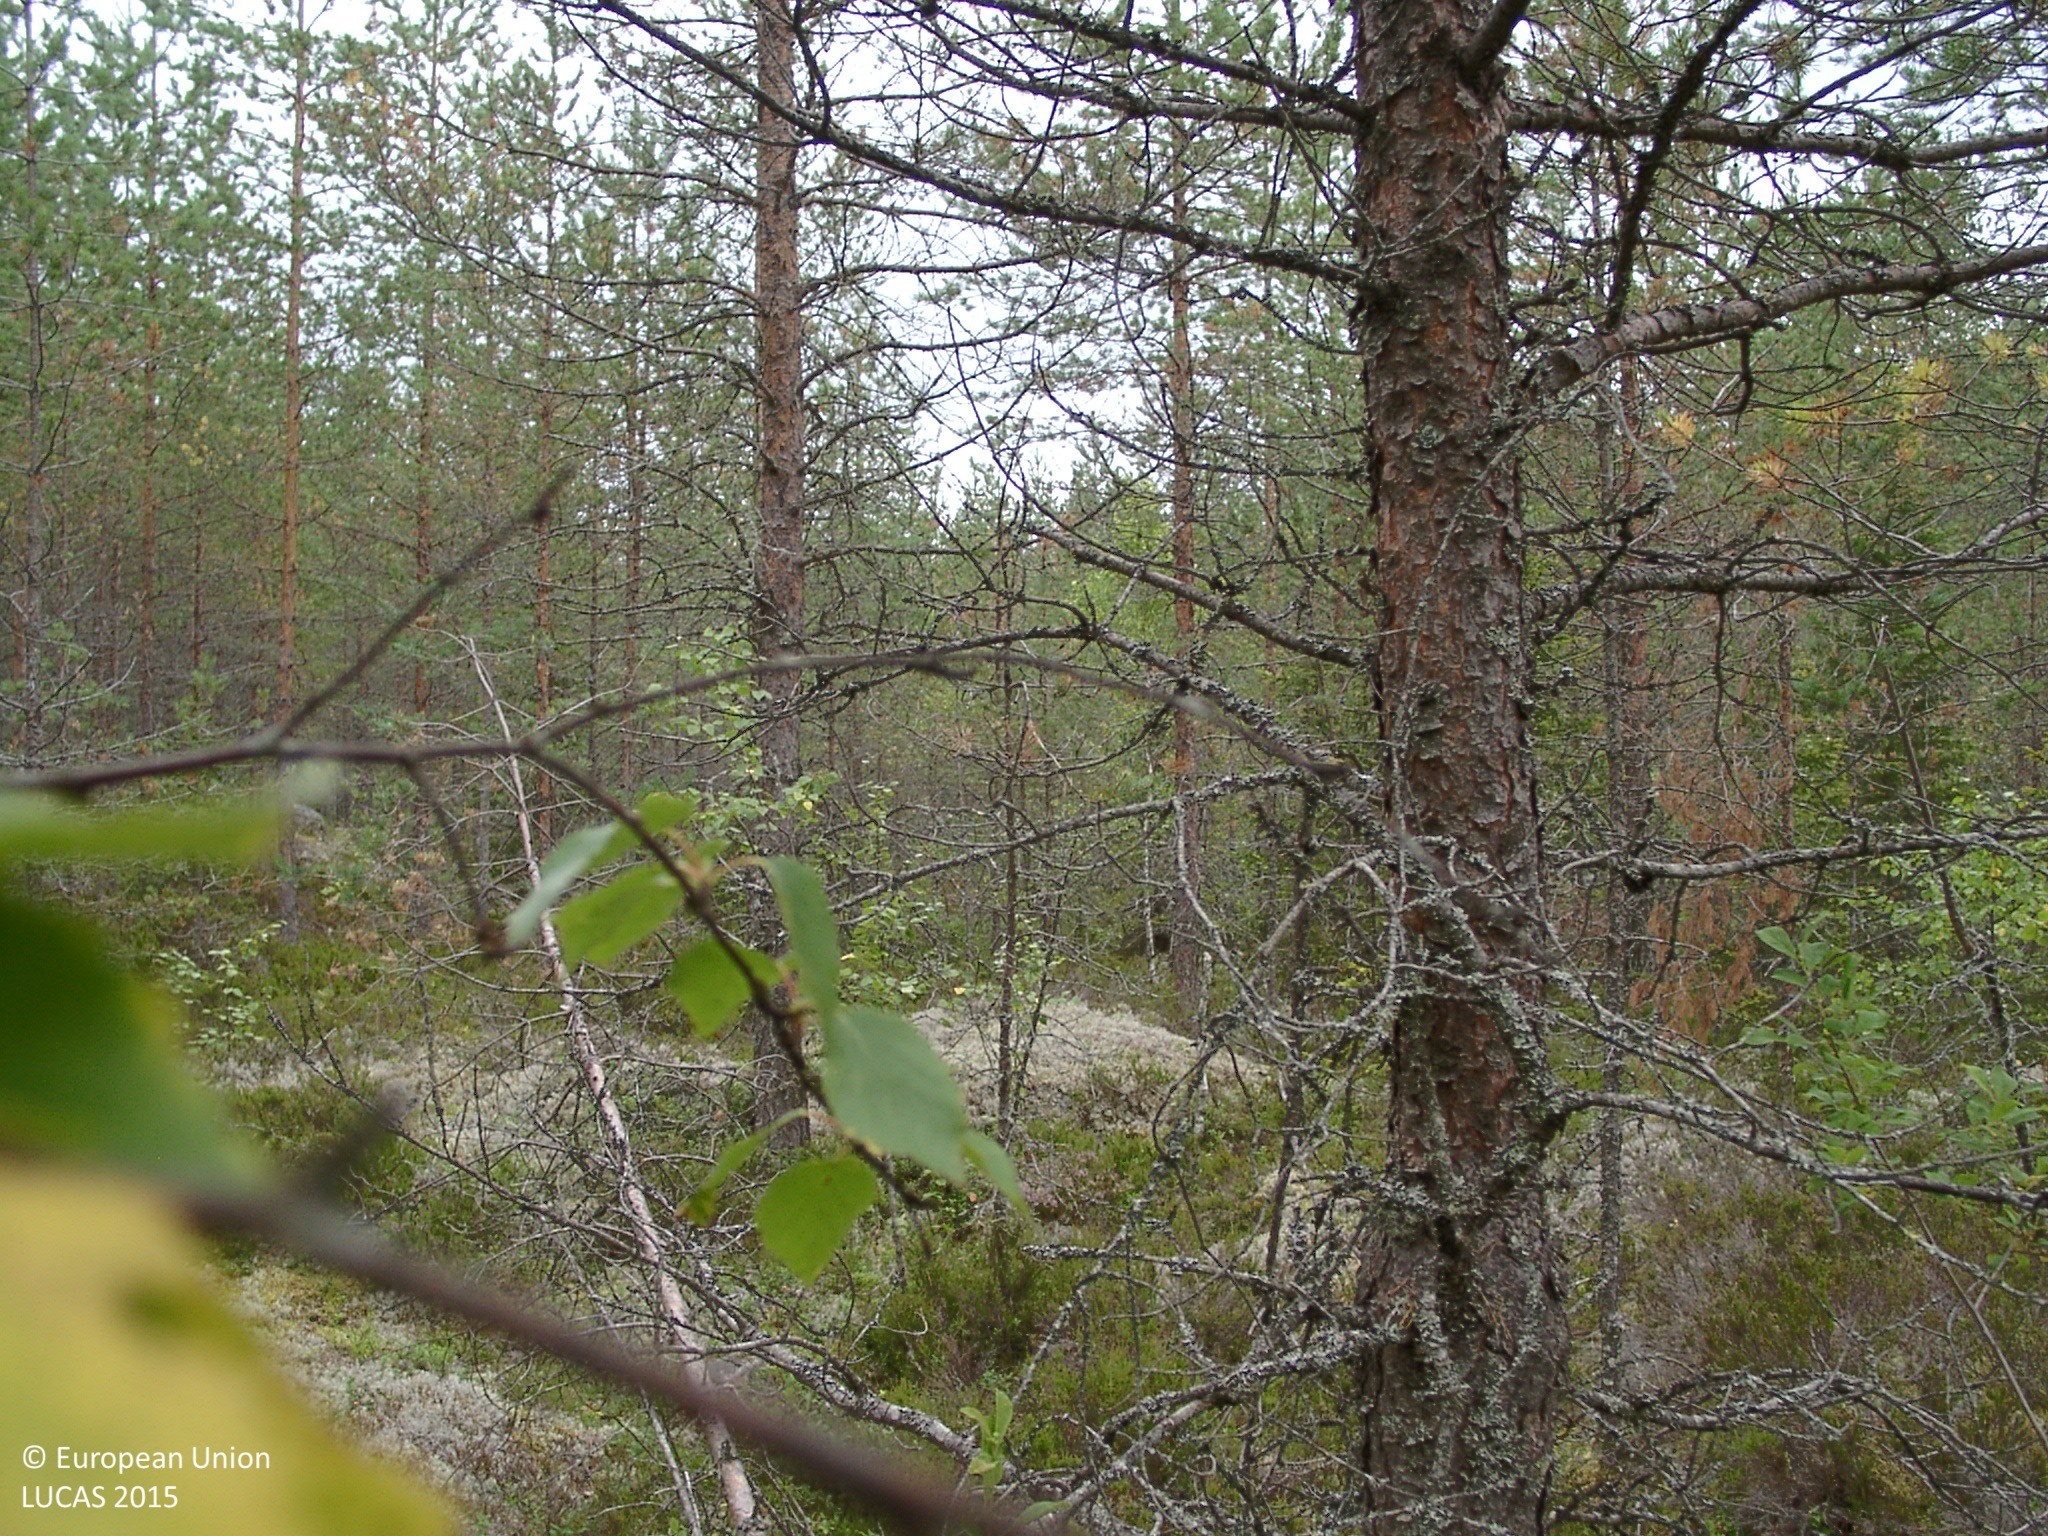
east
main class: Woodland
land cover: Other mixed woodland
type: boreal forest
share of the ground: 25 - 50 %
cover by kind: shrubs 45 %, coniferous forest trees 30 %, lichens and mosses 15 %, broadleaved forest trees 10 %
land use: Forestry
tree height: < 5 m
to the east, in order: Other mixed woodland; Pine dominated coniferous woodland; Shrubland with sparse tree cover; Other mixed woodland; Pine dominated coniferous woodland; Other mixed woodland; Ditches and canals; Other mixed woodland; Other coniferous woodland; Pine dominated coniferous woodland
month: August
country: FI
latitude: 62.6546
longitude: 24.5488
